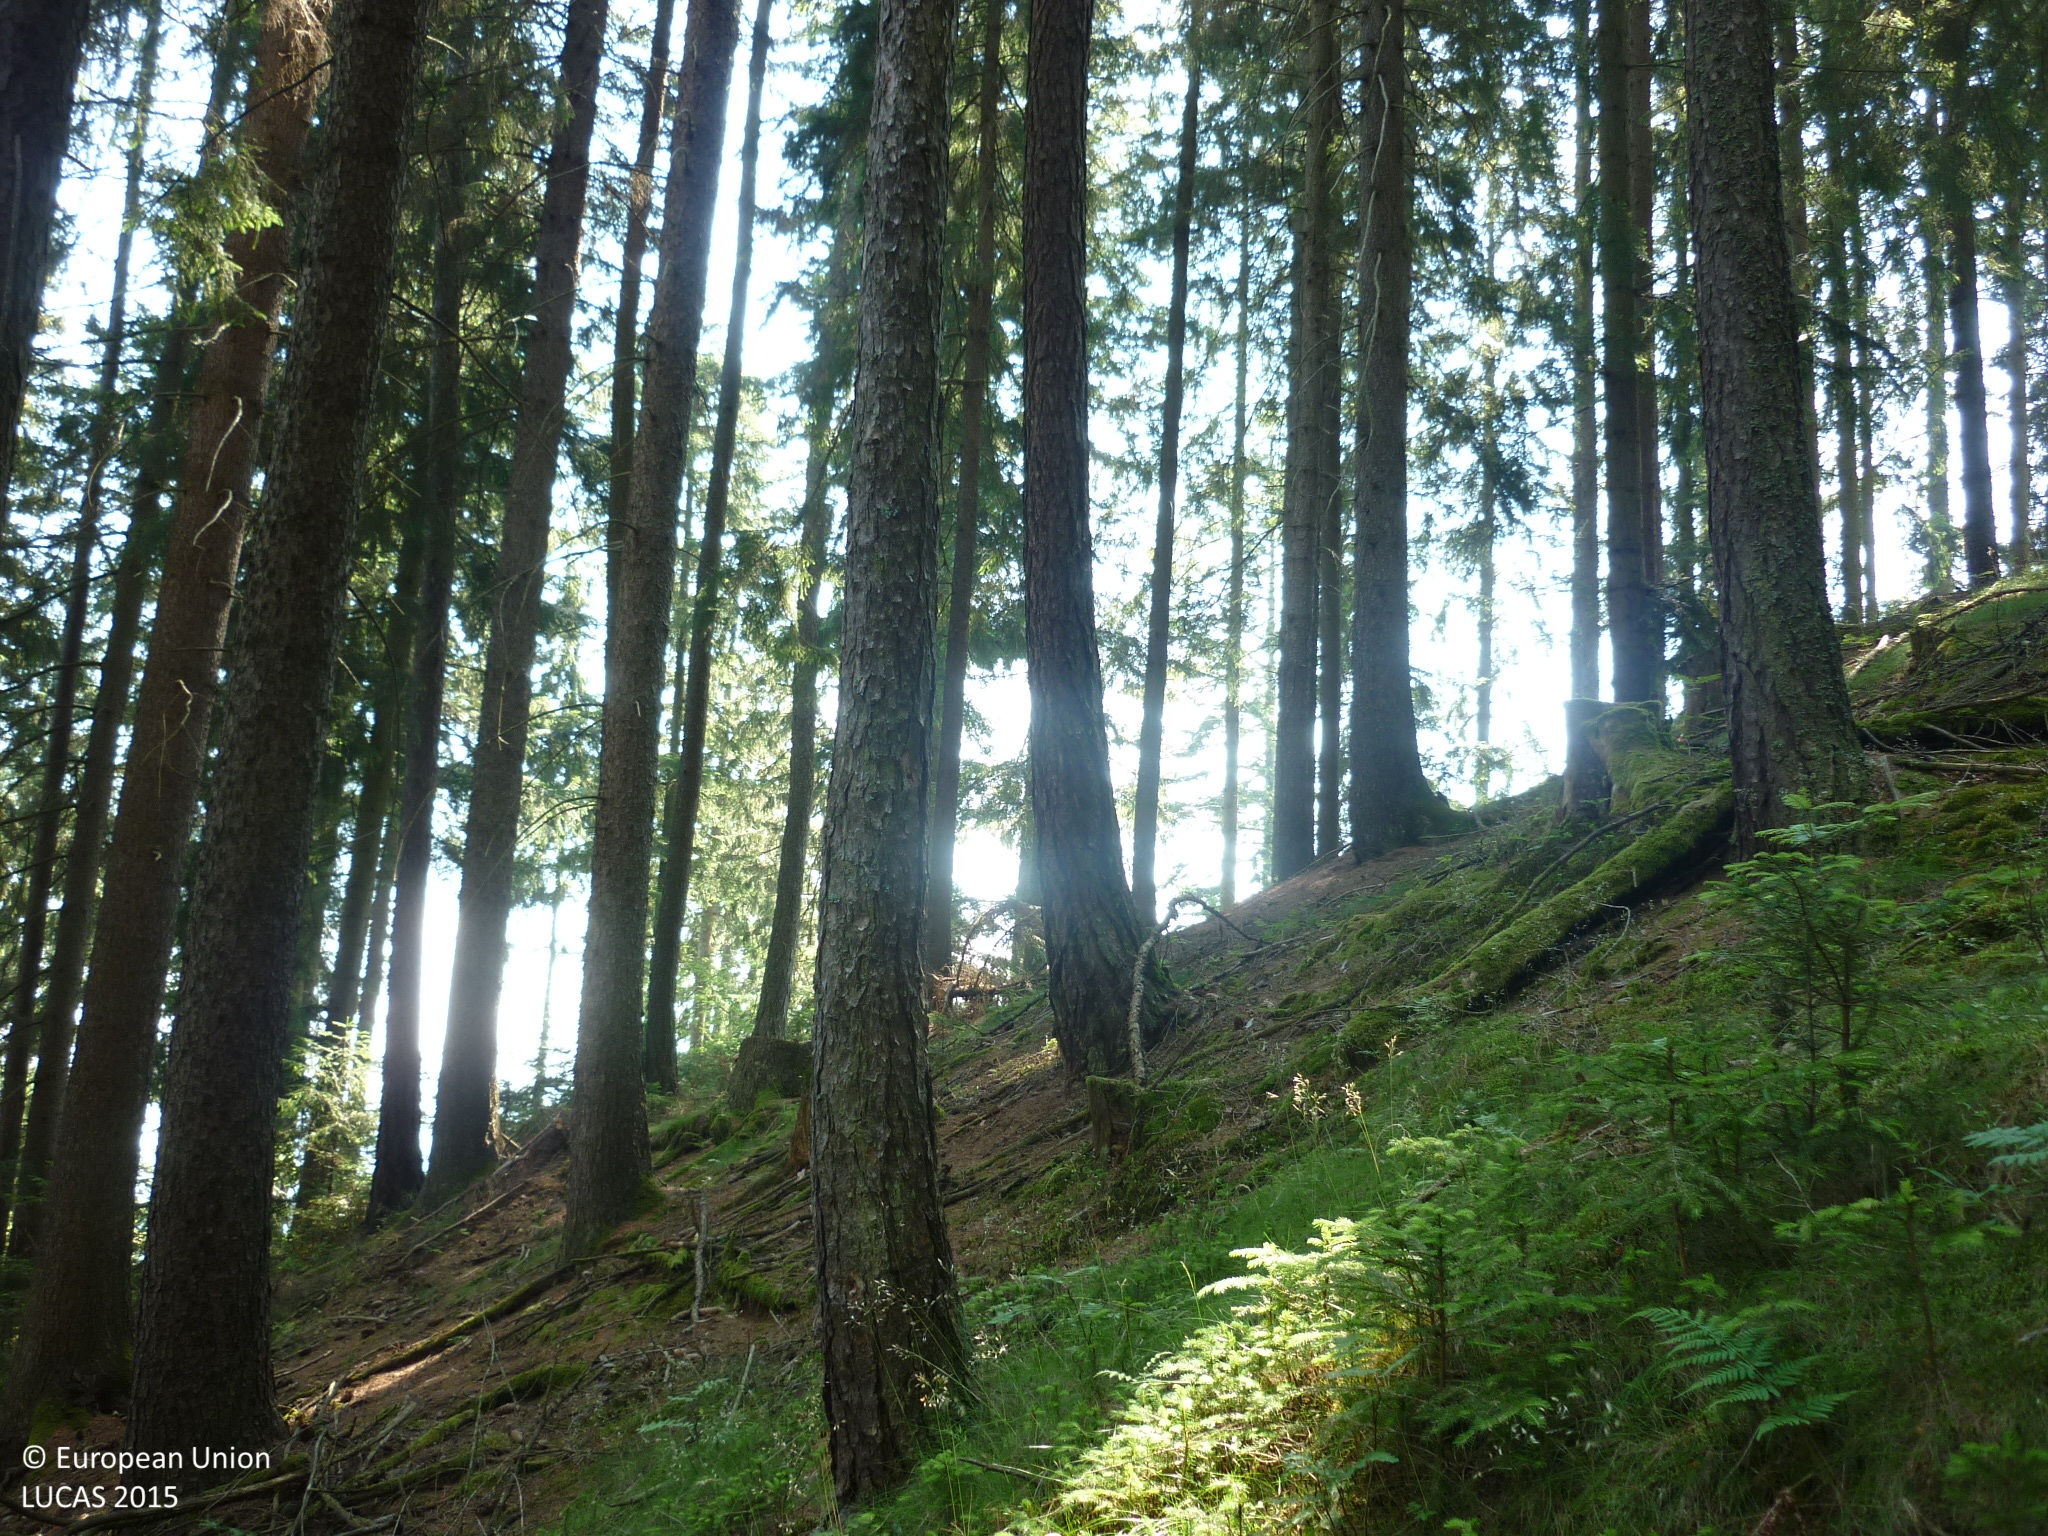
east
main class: Woodland
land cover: Spruce dominated coniferous woodland
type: alpine coniferous forest
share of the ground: > 75 %
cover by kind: coniferous forest trees 90 %, broadleaved forest trees 5 %, herbaceous plants 5 %
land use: Forestry
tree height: > 5 m
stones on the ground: < 10 %
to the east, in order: Spruce dominated coniferous woodland; Spruce dominated mixed woodland; Tracks; Spruce dominated coniferous woodland
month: July
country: AT
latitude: 47.2526
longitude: 14.8221
